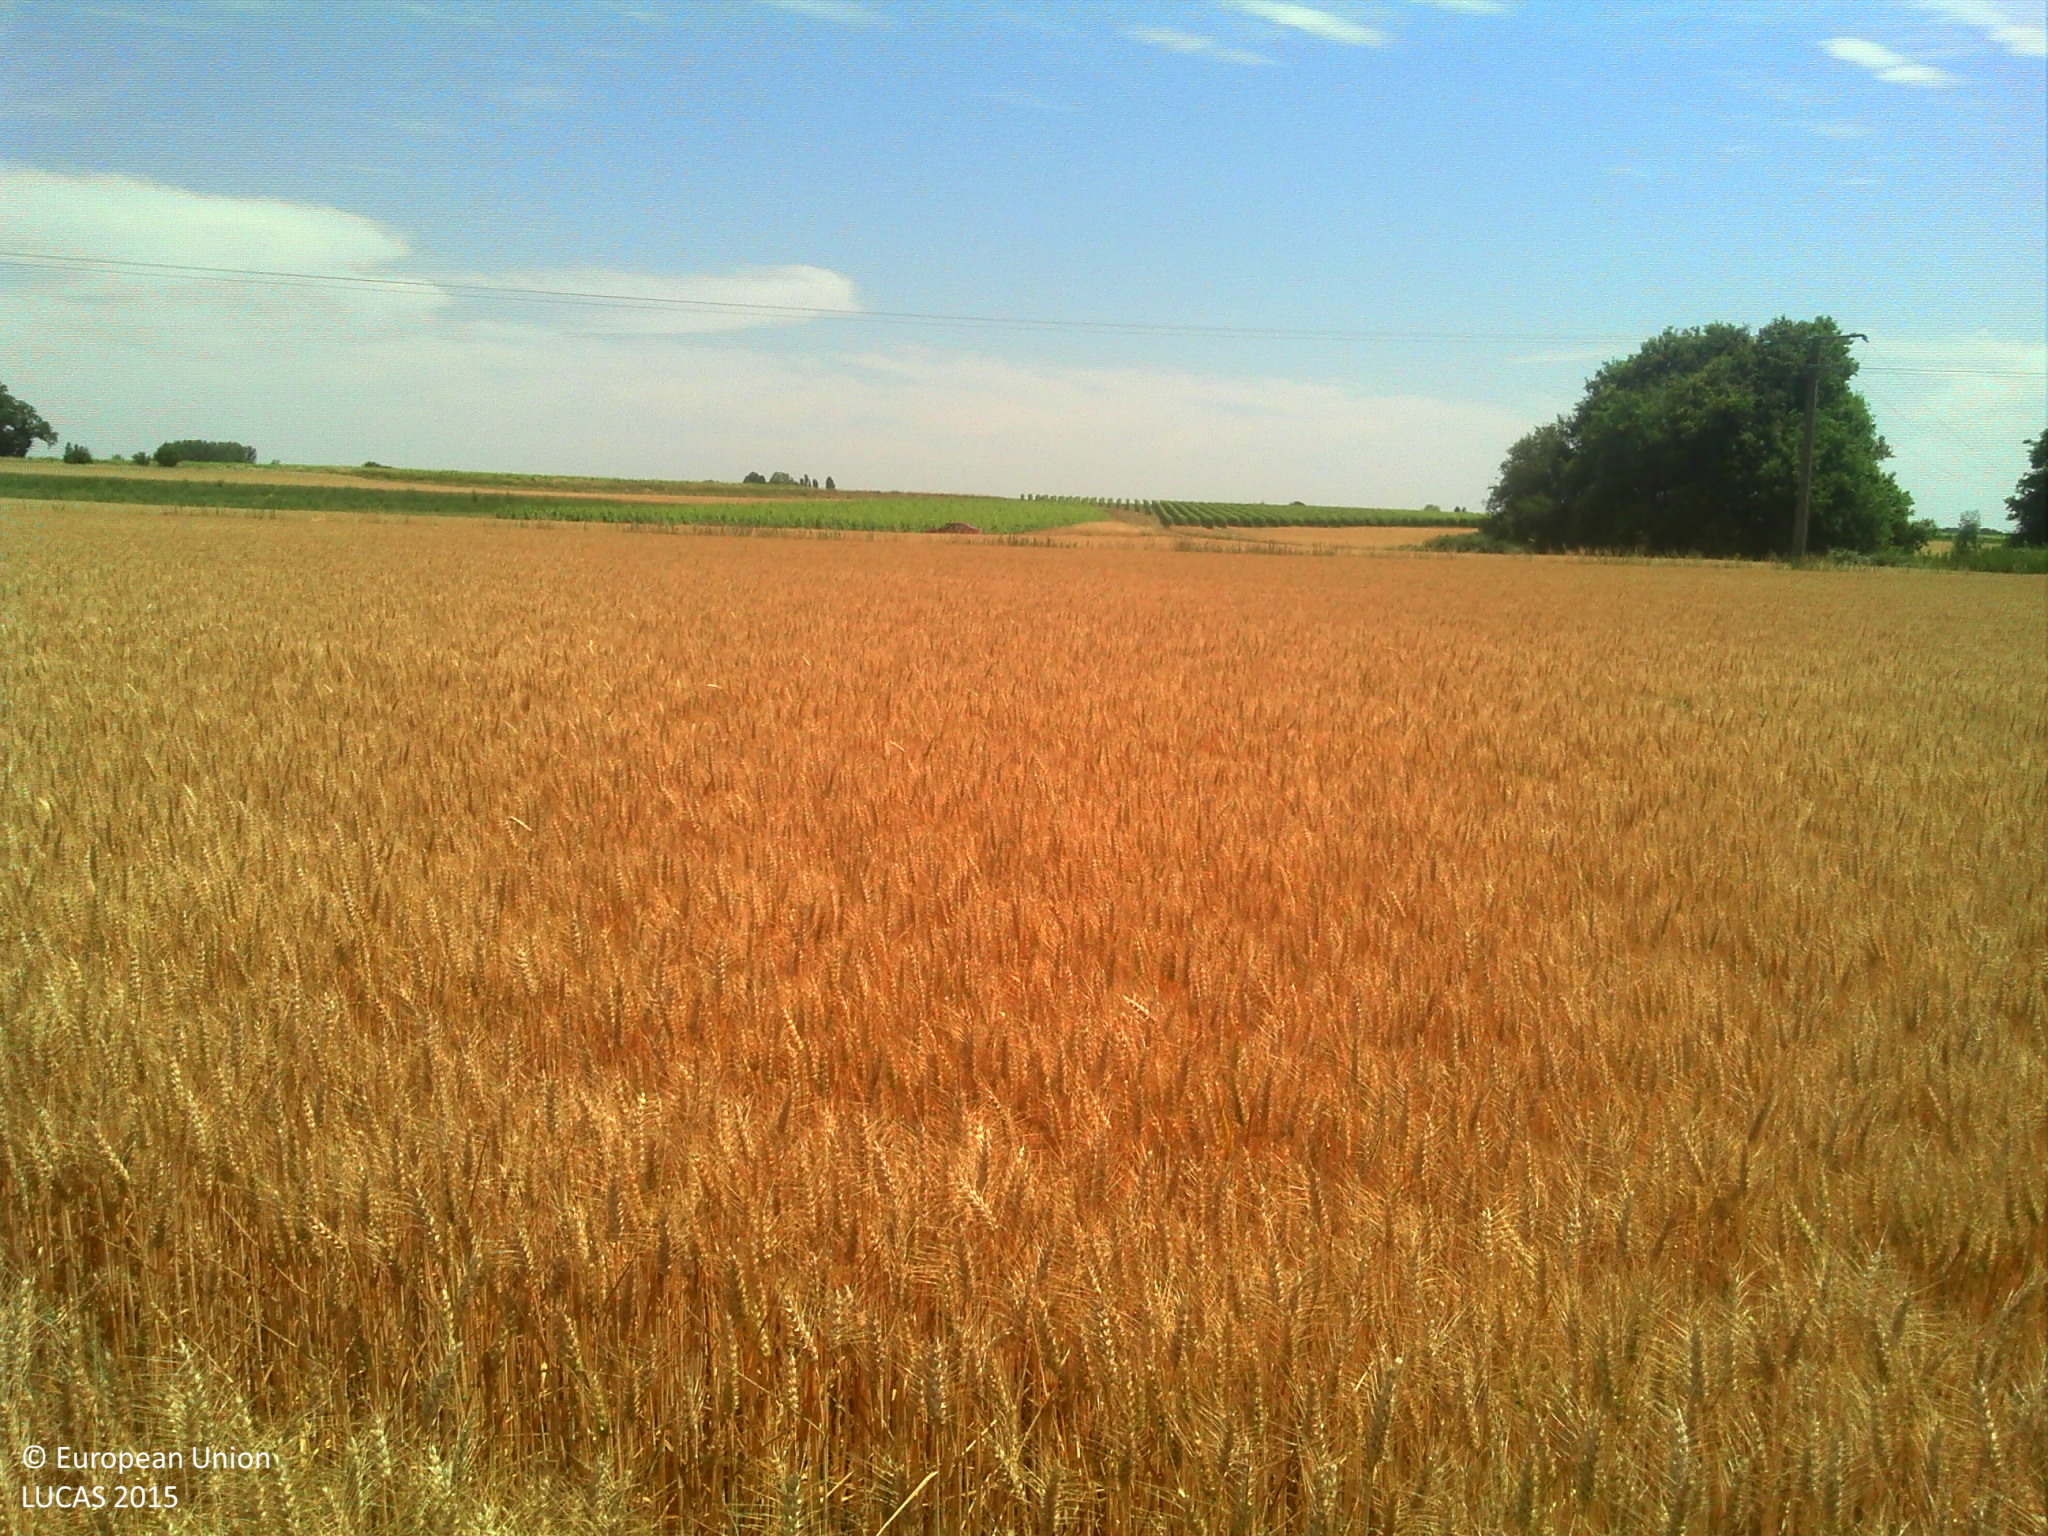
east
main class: Cropland
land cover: Durum wheat
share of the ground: > 75 %
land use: Agriculture (excluding fallow land and kitchen gardens)
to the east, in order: Durum wheat; Tracks; Grass margins; Ditches and canals; Durum wheat; Temporary grasslands
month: June
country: FR
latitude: 47.3952
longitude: 1.3605
